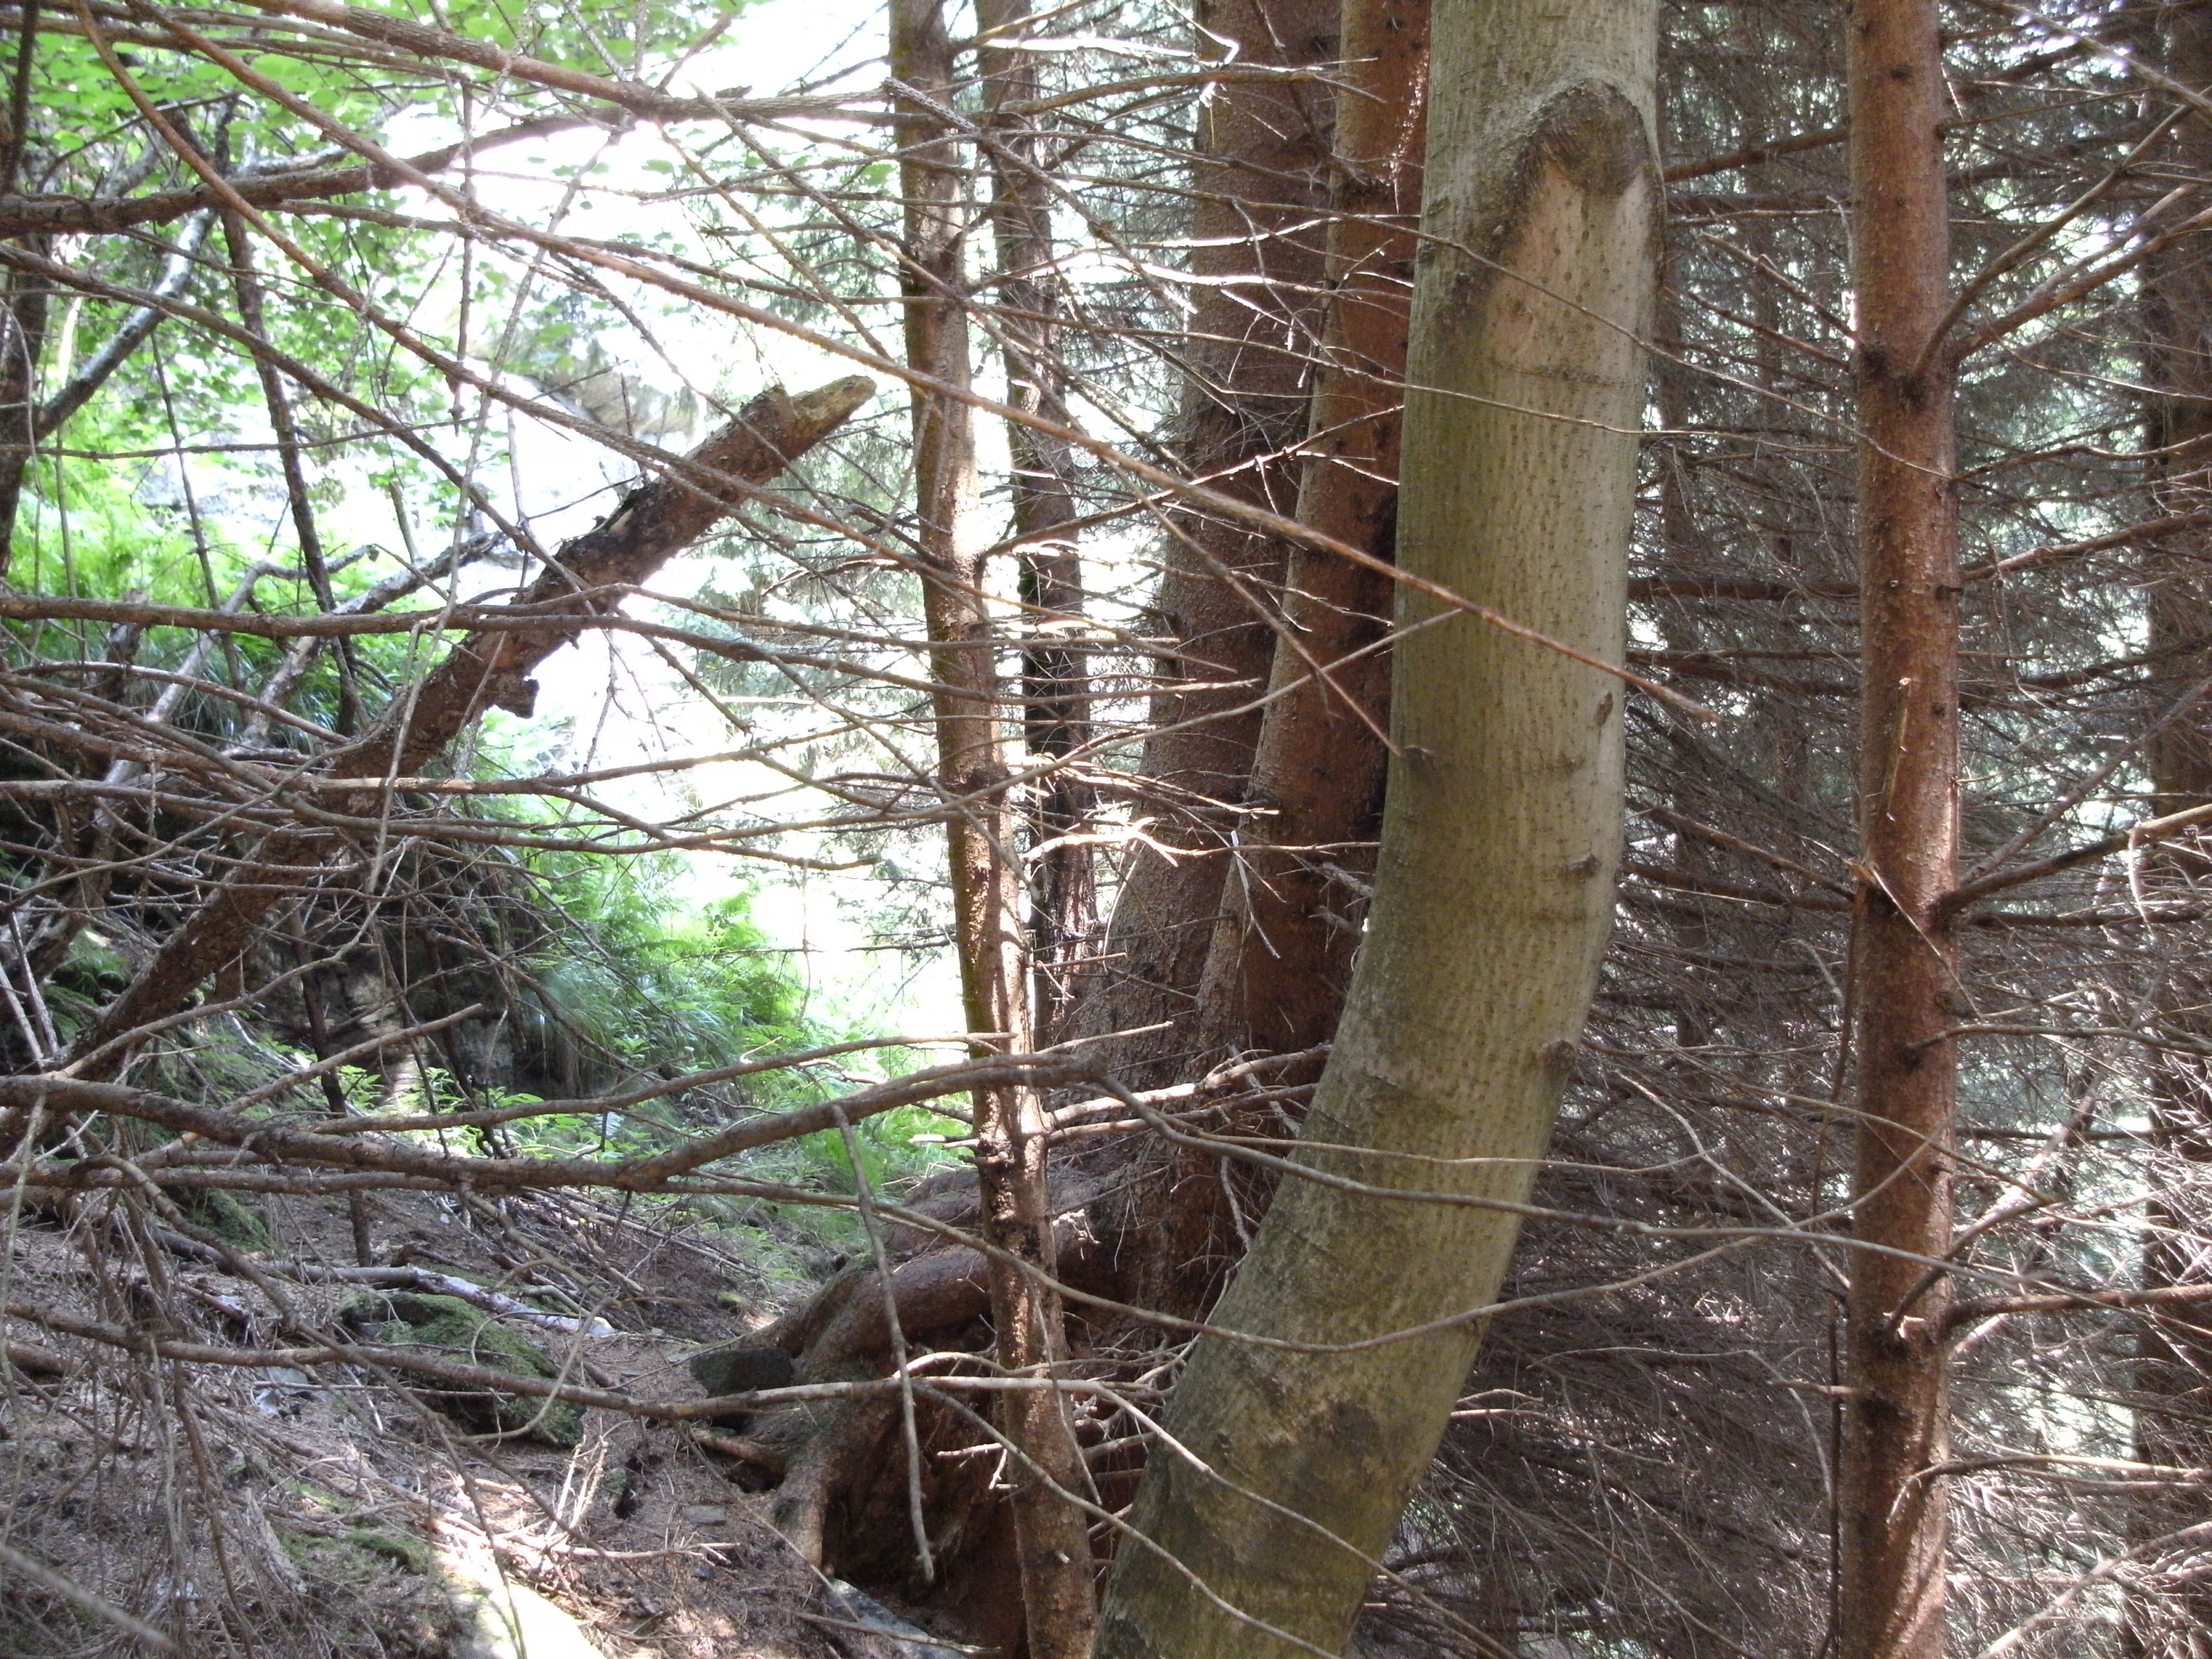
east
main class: Woodland
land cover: Spruce dominated coniferous woodland
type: alpine coniferous forest
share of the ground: > 75 %
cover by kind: coniferous forest trees 85 %, lichens and mosses 5 %, unconsolidated bare surface 5 %
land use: Forestry
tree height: > 5 m
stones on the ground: 10 - 25 %
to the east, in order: Spruce dominated coniferous woodland
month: July
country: AT
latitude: 46.7785
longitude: 14.9360
